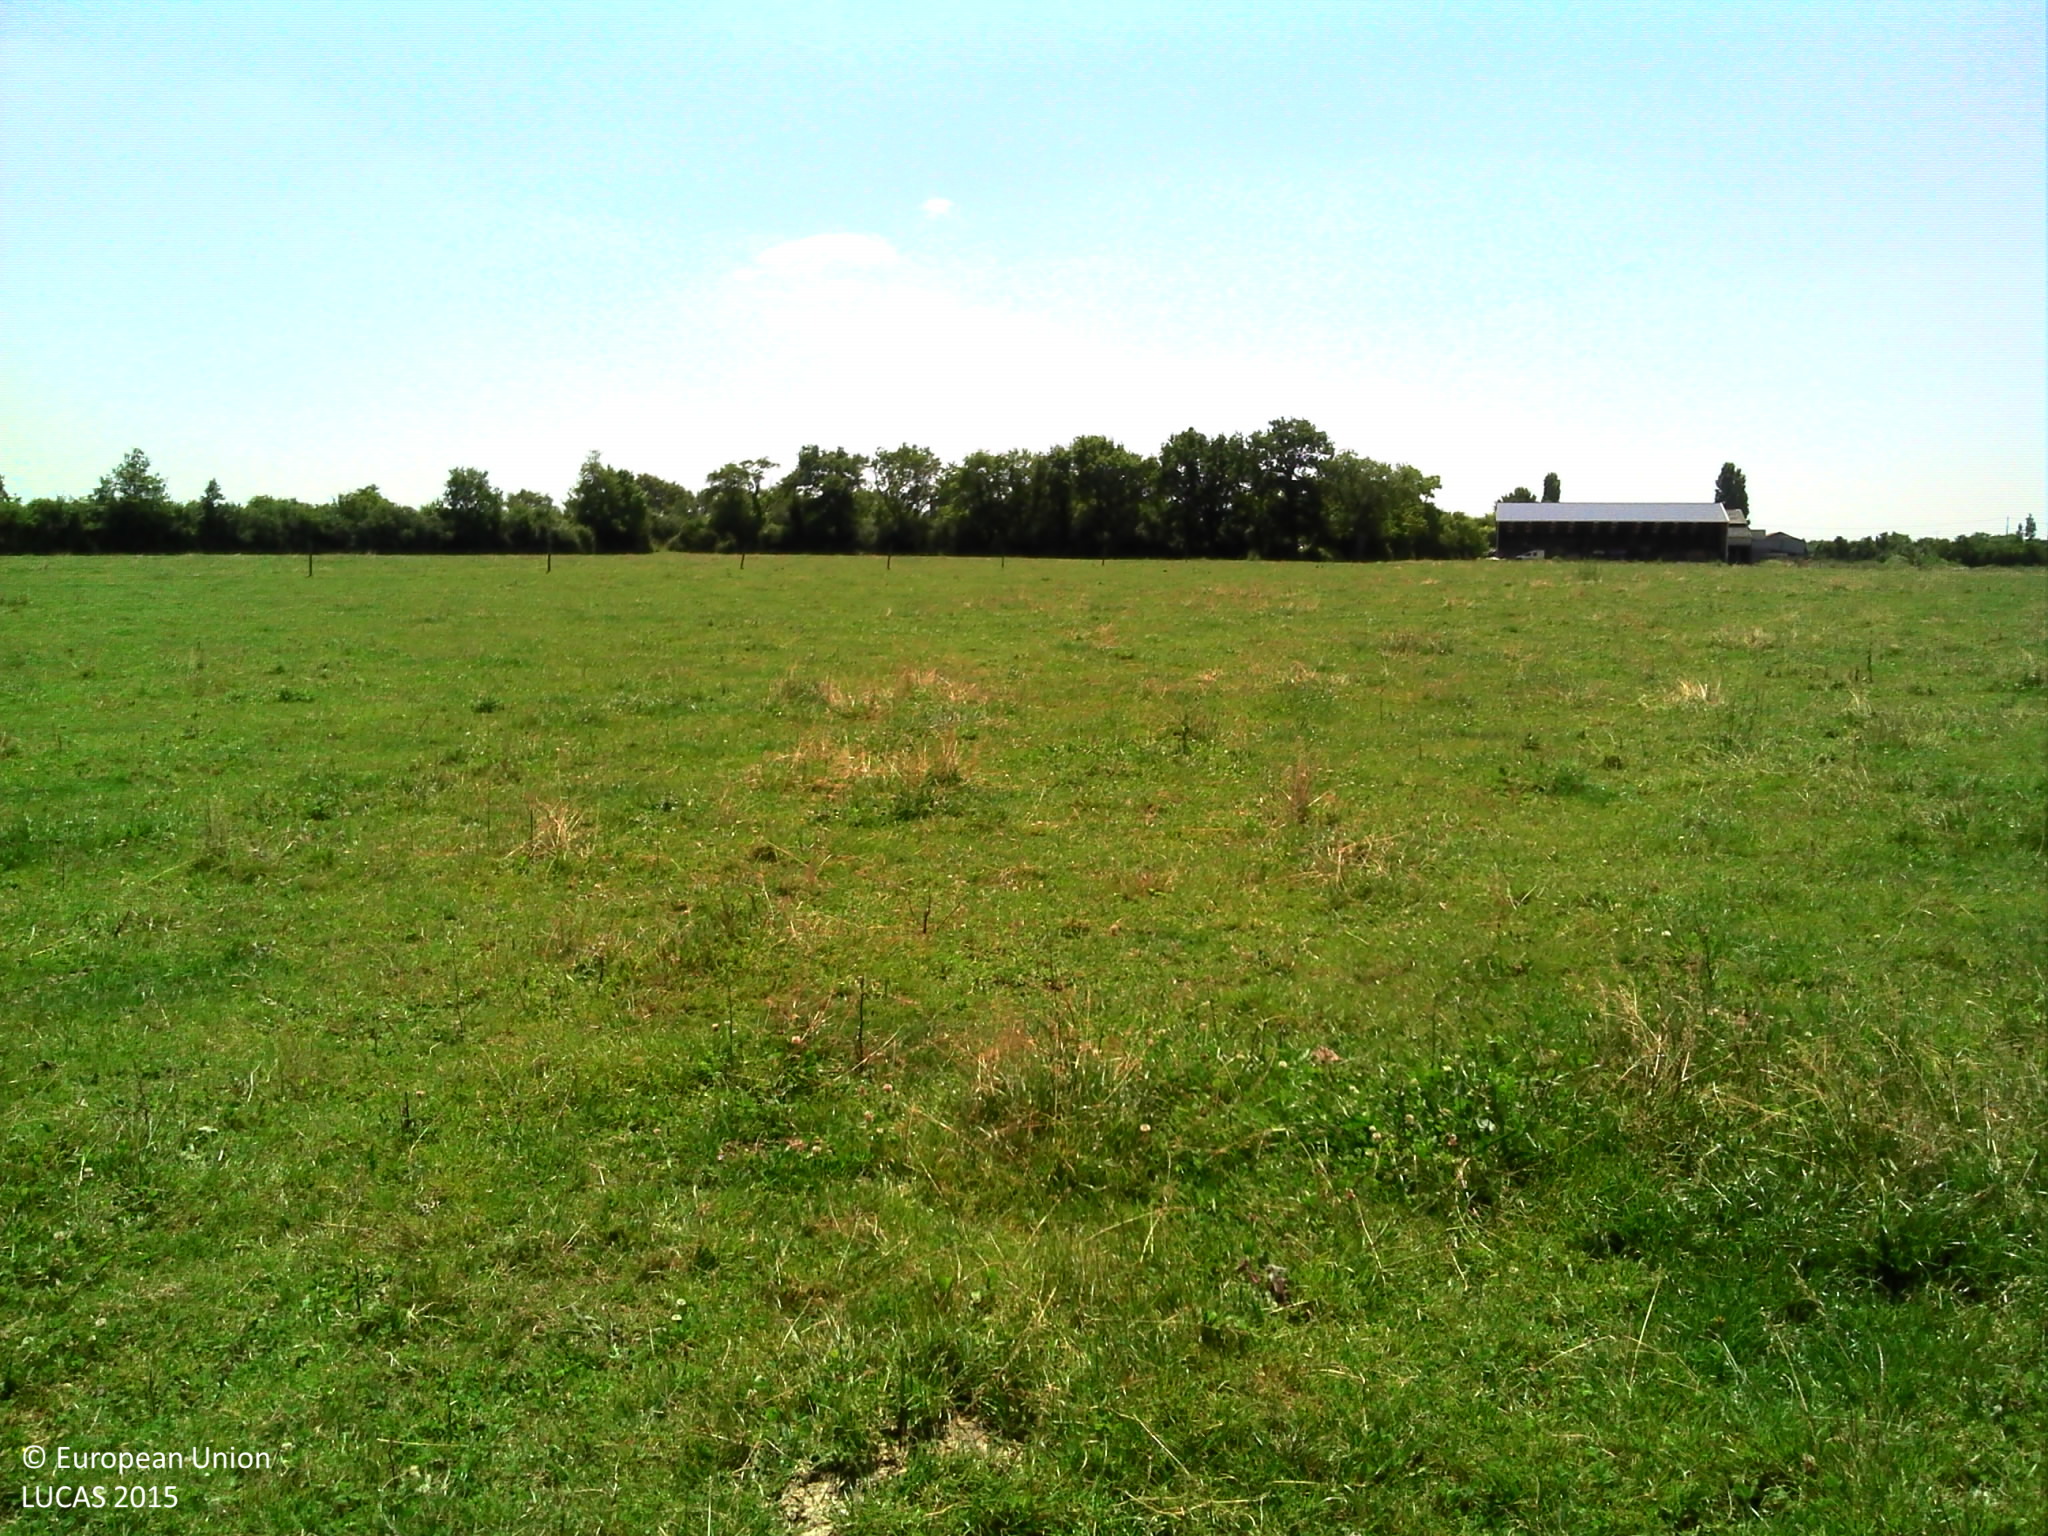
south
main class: Cropland
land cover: Temporary grasslands
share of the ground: > 75 %
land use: Agriculture (excluding fallow land and kitchen gardens)
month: June
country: FR
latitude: 47.0540
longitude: -1.8537
